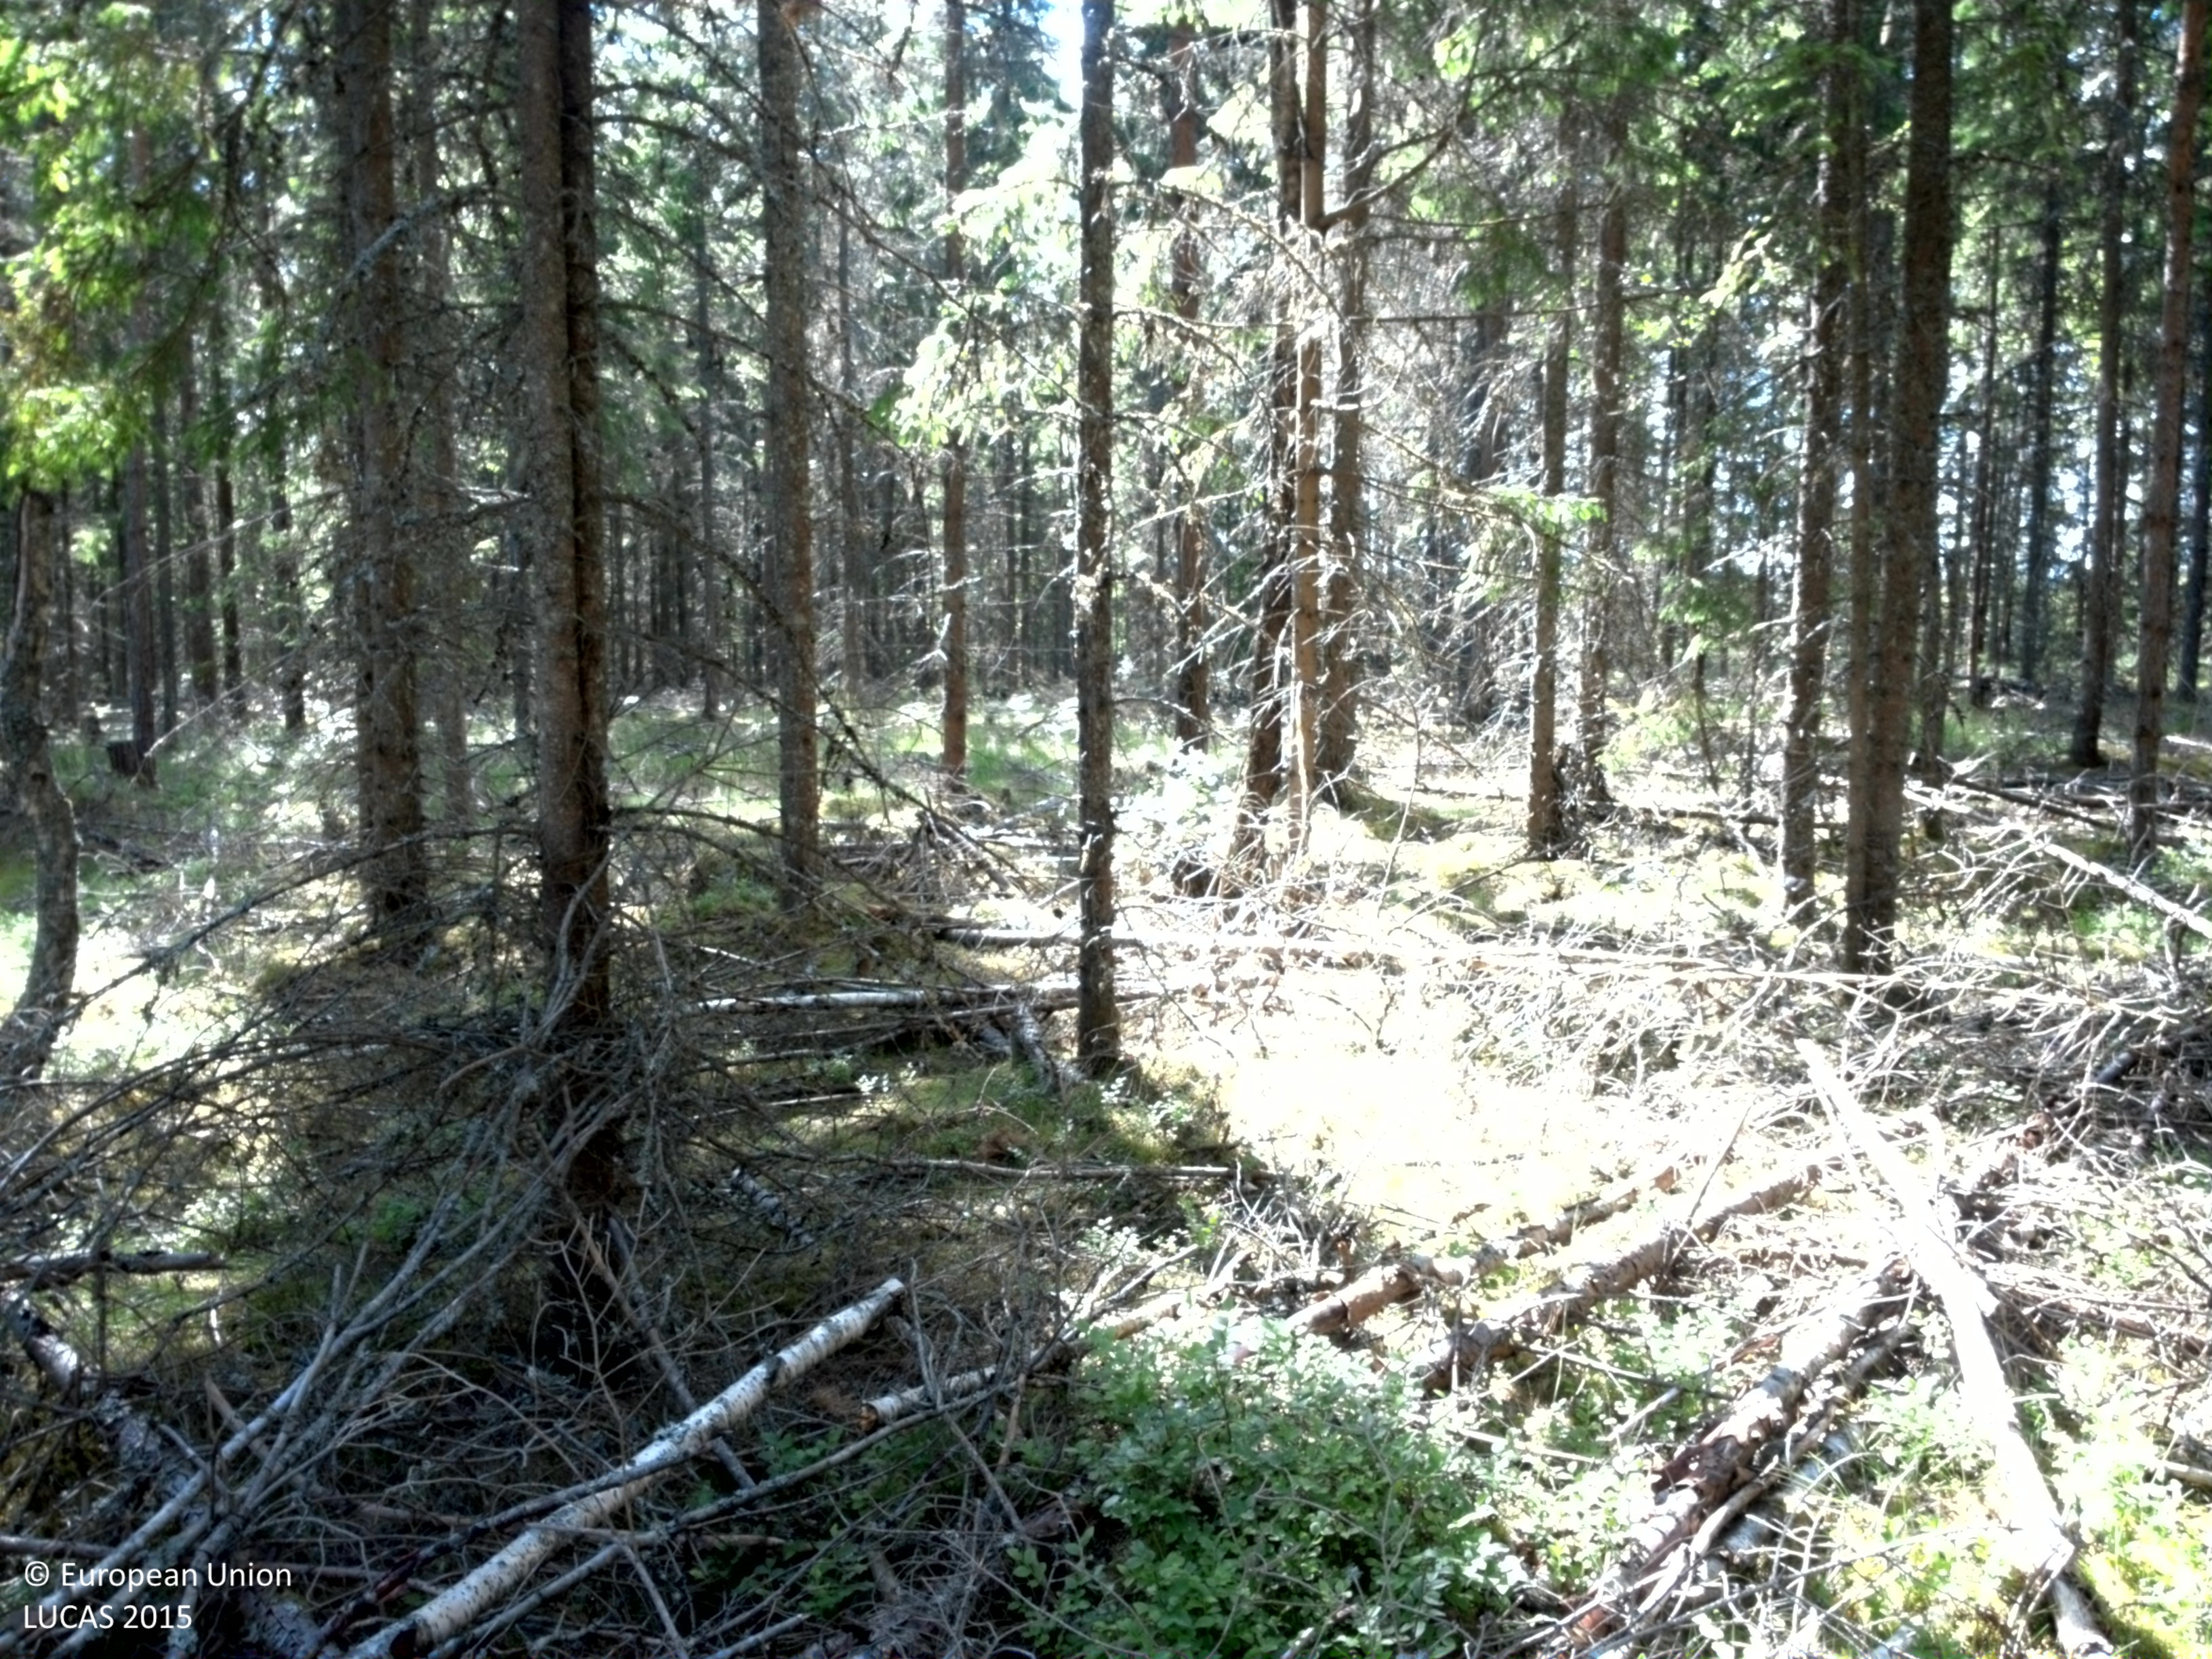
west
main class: Woodland
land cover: Pine dominated coniferous woodland
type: boreal forest
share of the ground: 50 - 75 %
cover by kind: coniferous forest trees 65 %, lichens and mosses 25 %, broadleaved forest trees 10 %
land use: Forestry
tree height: > 5 m
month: June
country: SE
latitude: 57.7854
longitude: 13.8801
